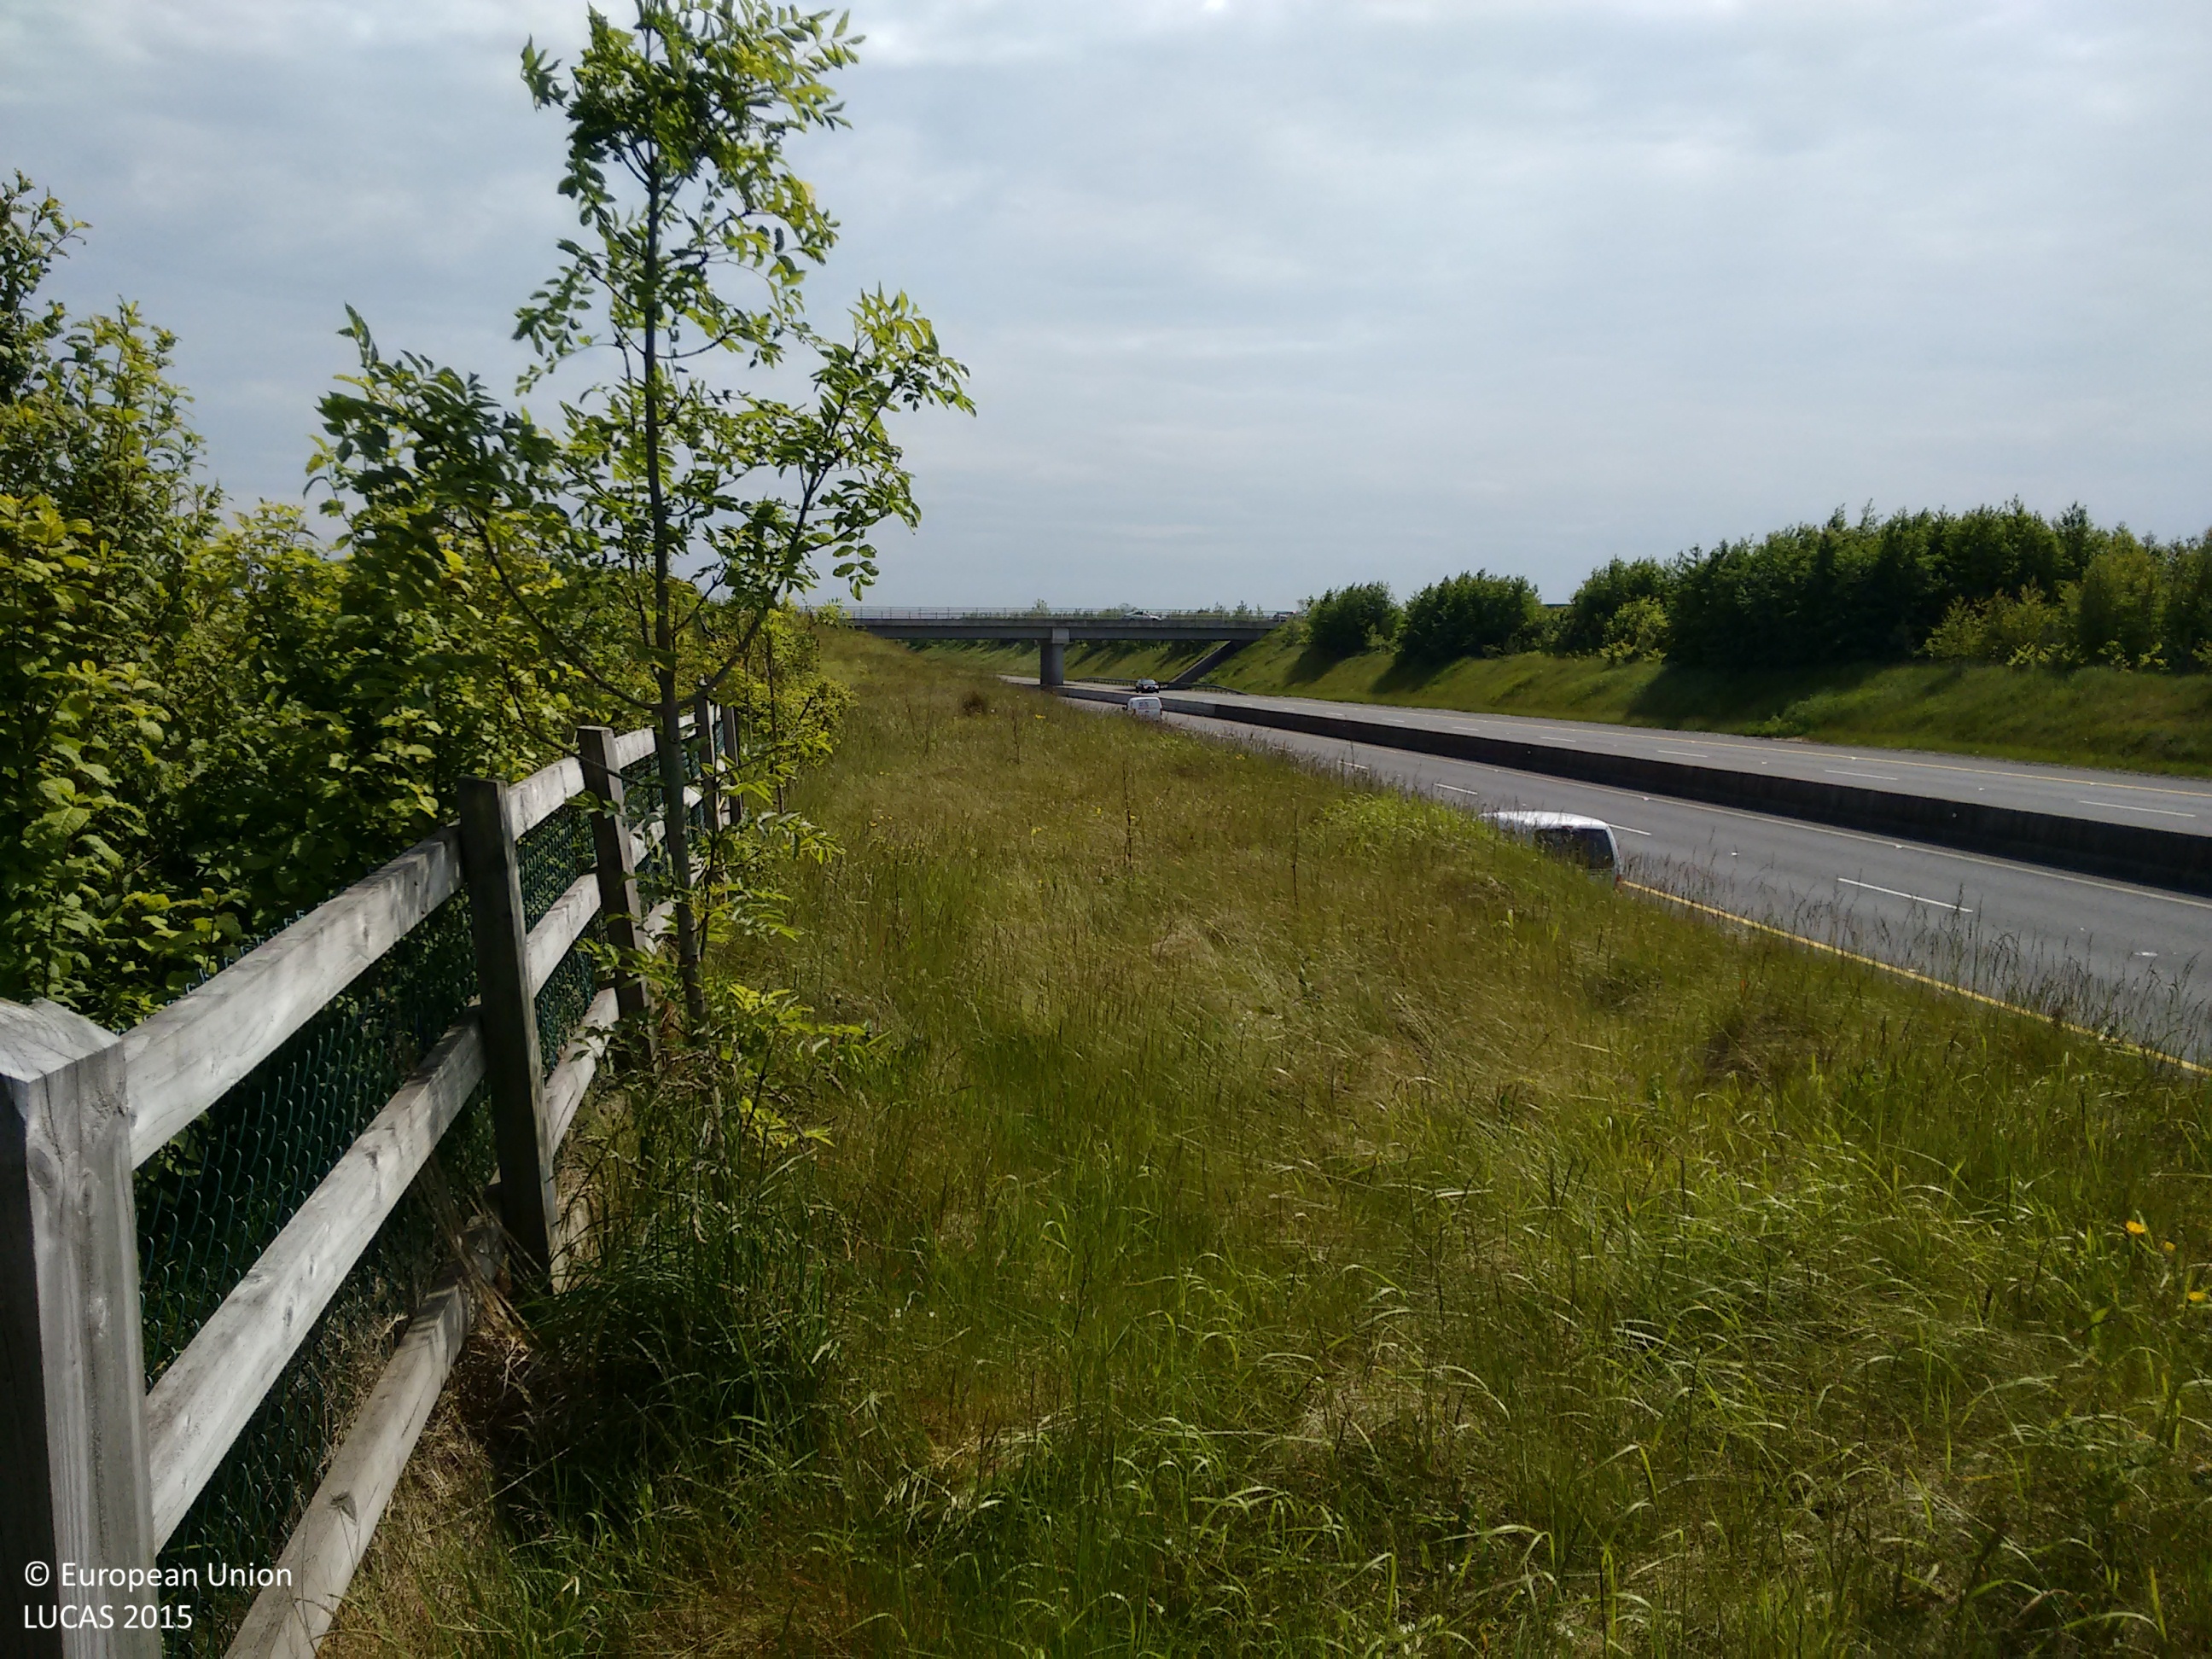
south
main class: Woodland
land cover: Broadleaved woodland
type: acidophilous oak and oak-birch forest
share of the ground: > 75 %
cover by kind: broadleaved forest trees 90 %, coniferous forest trees 10 %
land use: Road transport
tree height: < 5 m
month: June
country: IE
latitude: 53.5716
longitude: -6.5736
